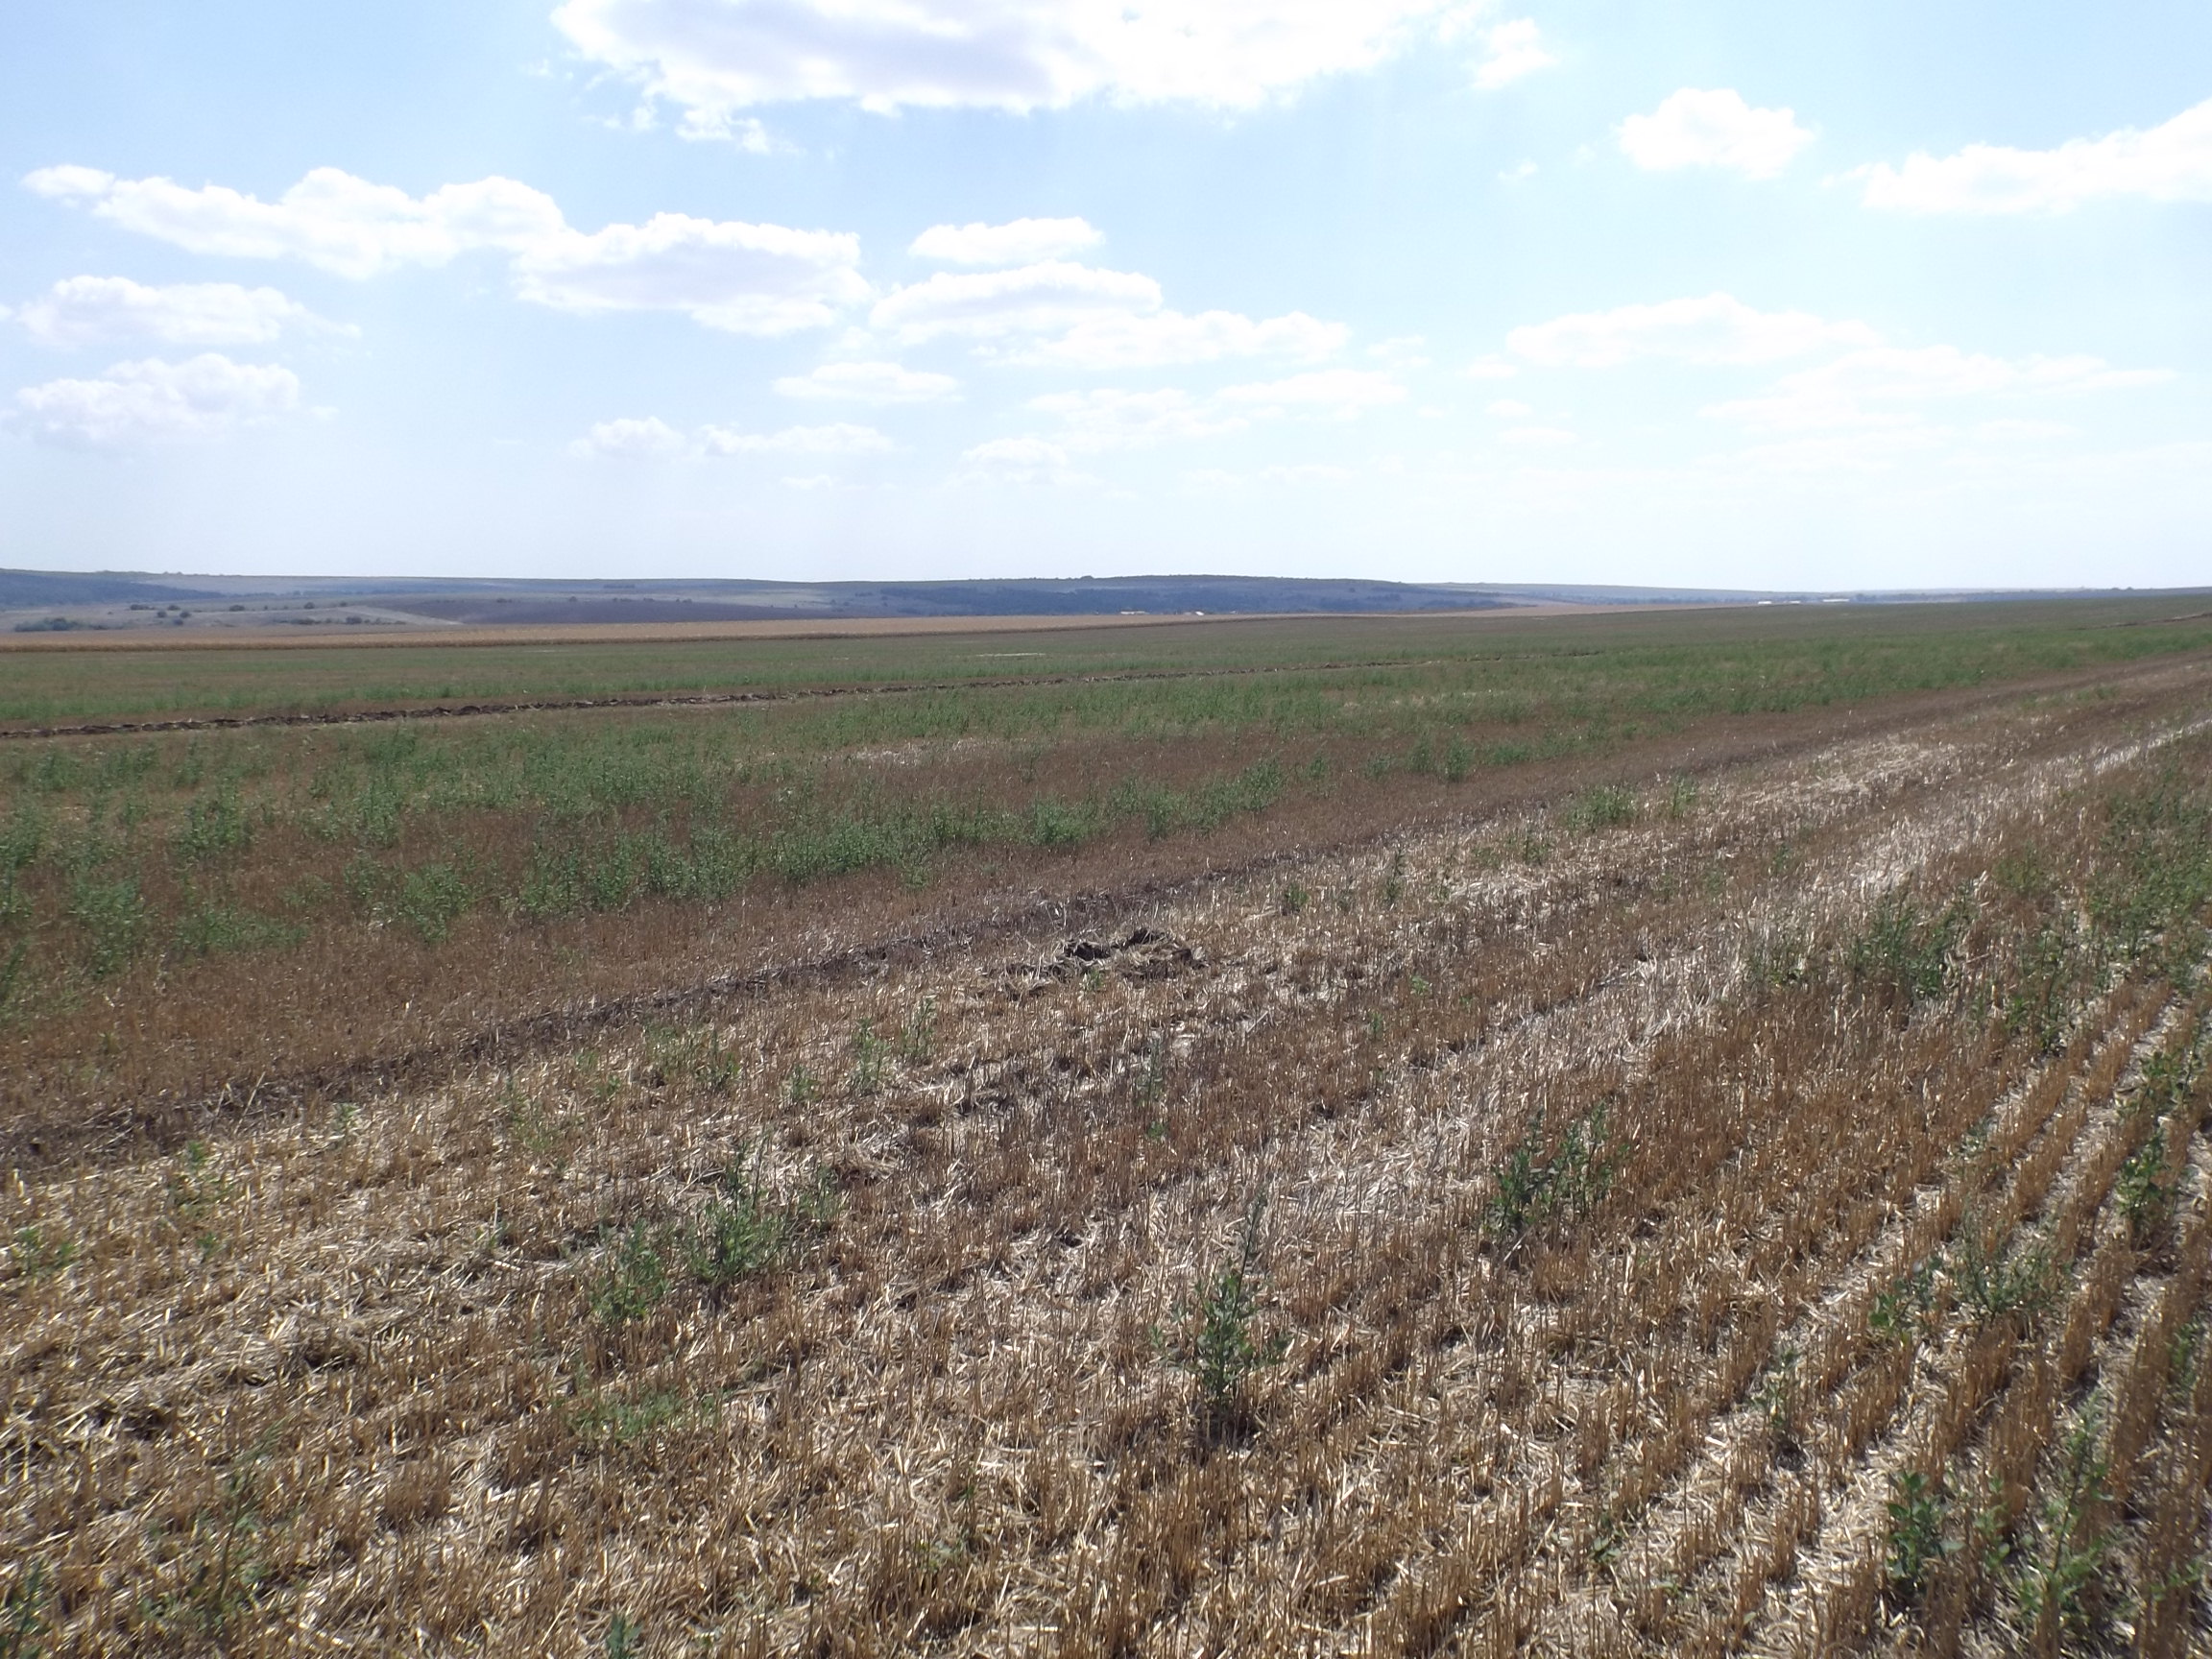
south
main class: Cropland
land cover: Common wheat
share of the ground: 50 - 75 %
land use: Agriculture (excluding fallow land and kitchen gardens)
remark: Harvested field
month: August
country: BG
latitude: 43.4406
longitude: 27.4893
